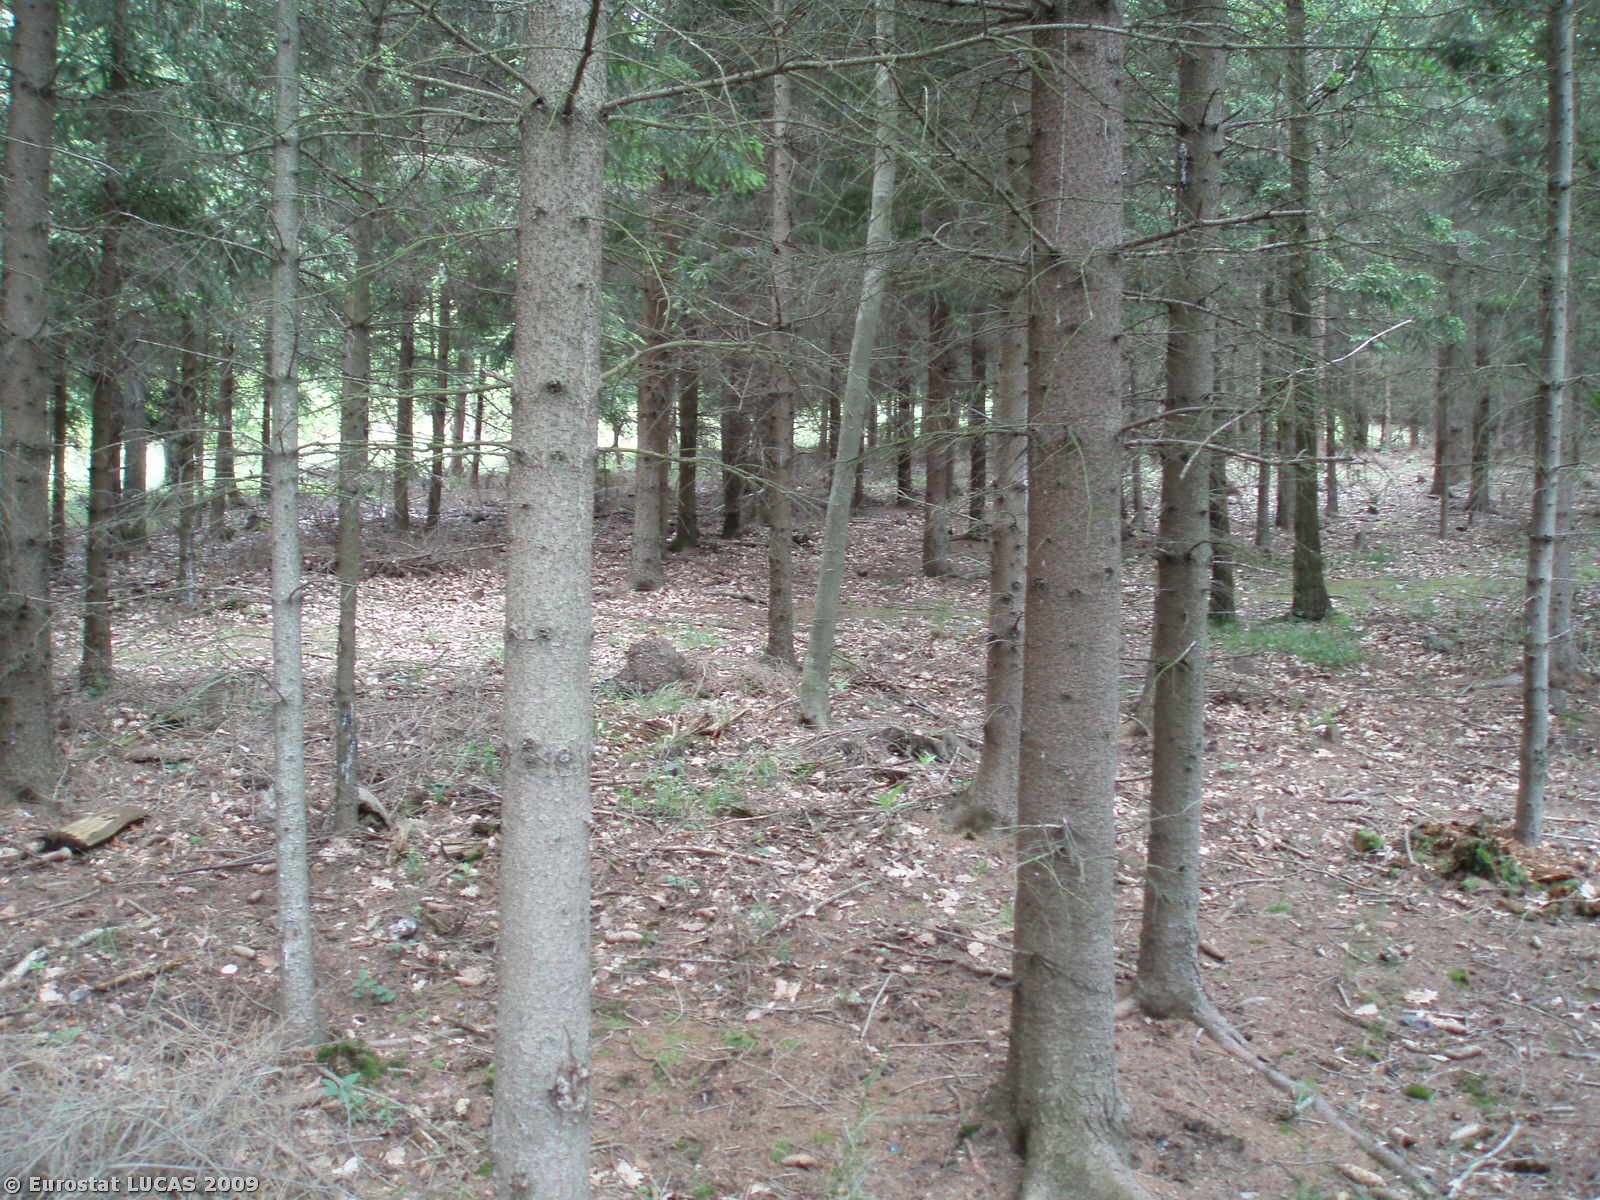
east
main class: Woodland
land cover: Coniferous woodland
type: hemiboreal forest and nemoral coniferous forest and mixed broadleaved-coniferous forest
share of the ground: > 75 %
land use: Forestry
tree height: > 5 m
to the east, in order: Coniferous woodland; Tracks; Coniferous woodland; Groves; Broadleaved woodland; Electric lines; Tracks; Coniferous woodland; Tracks; Coniferous woodland; Mixed woodland; Tracks; Mixed woodland
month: May
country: CZ
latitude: 49.8532
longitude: 14.2433
